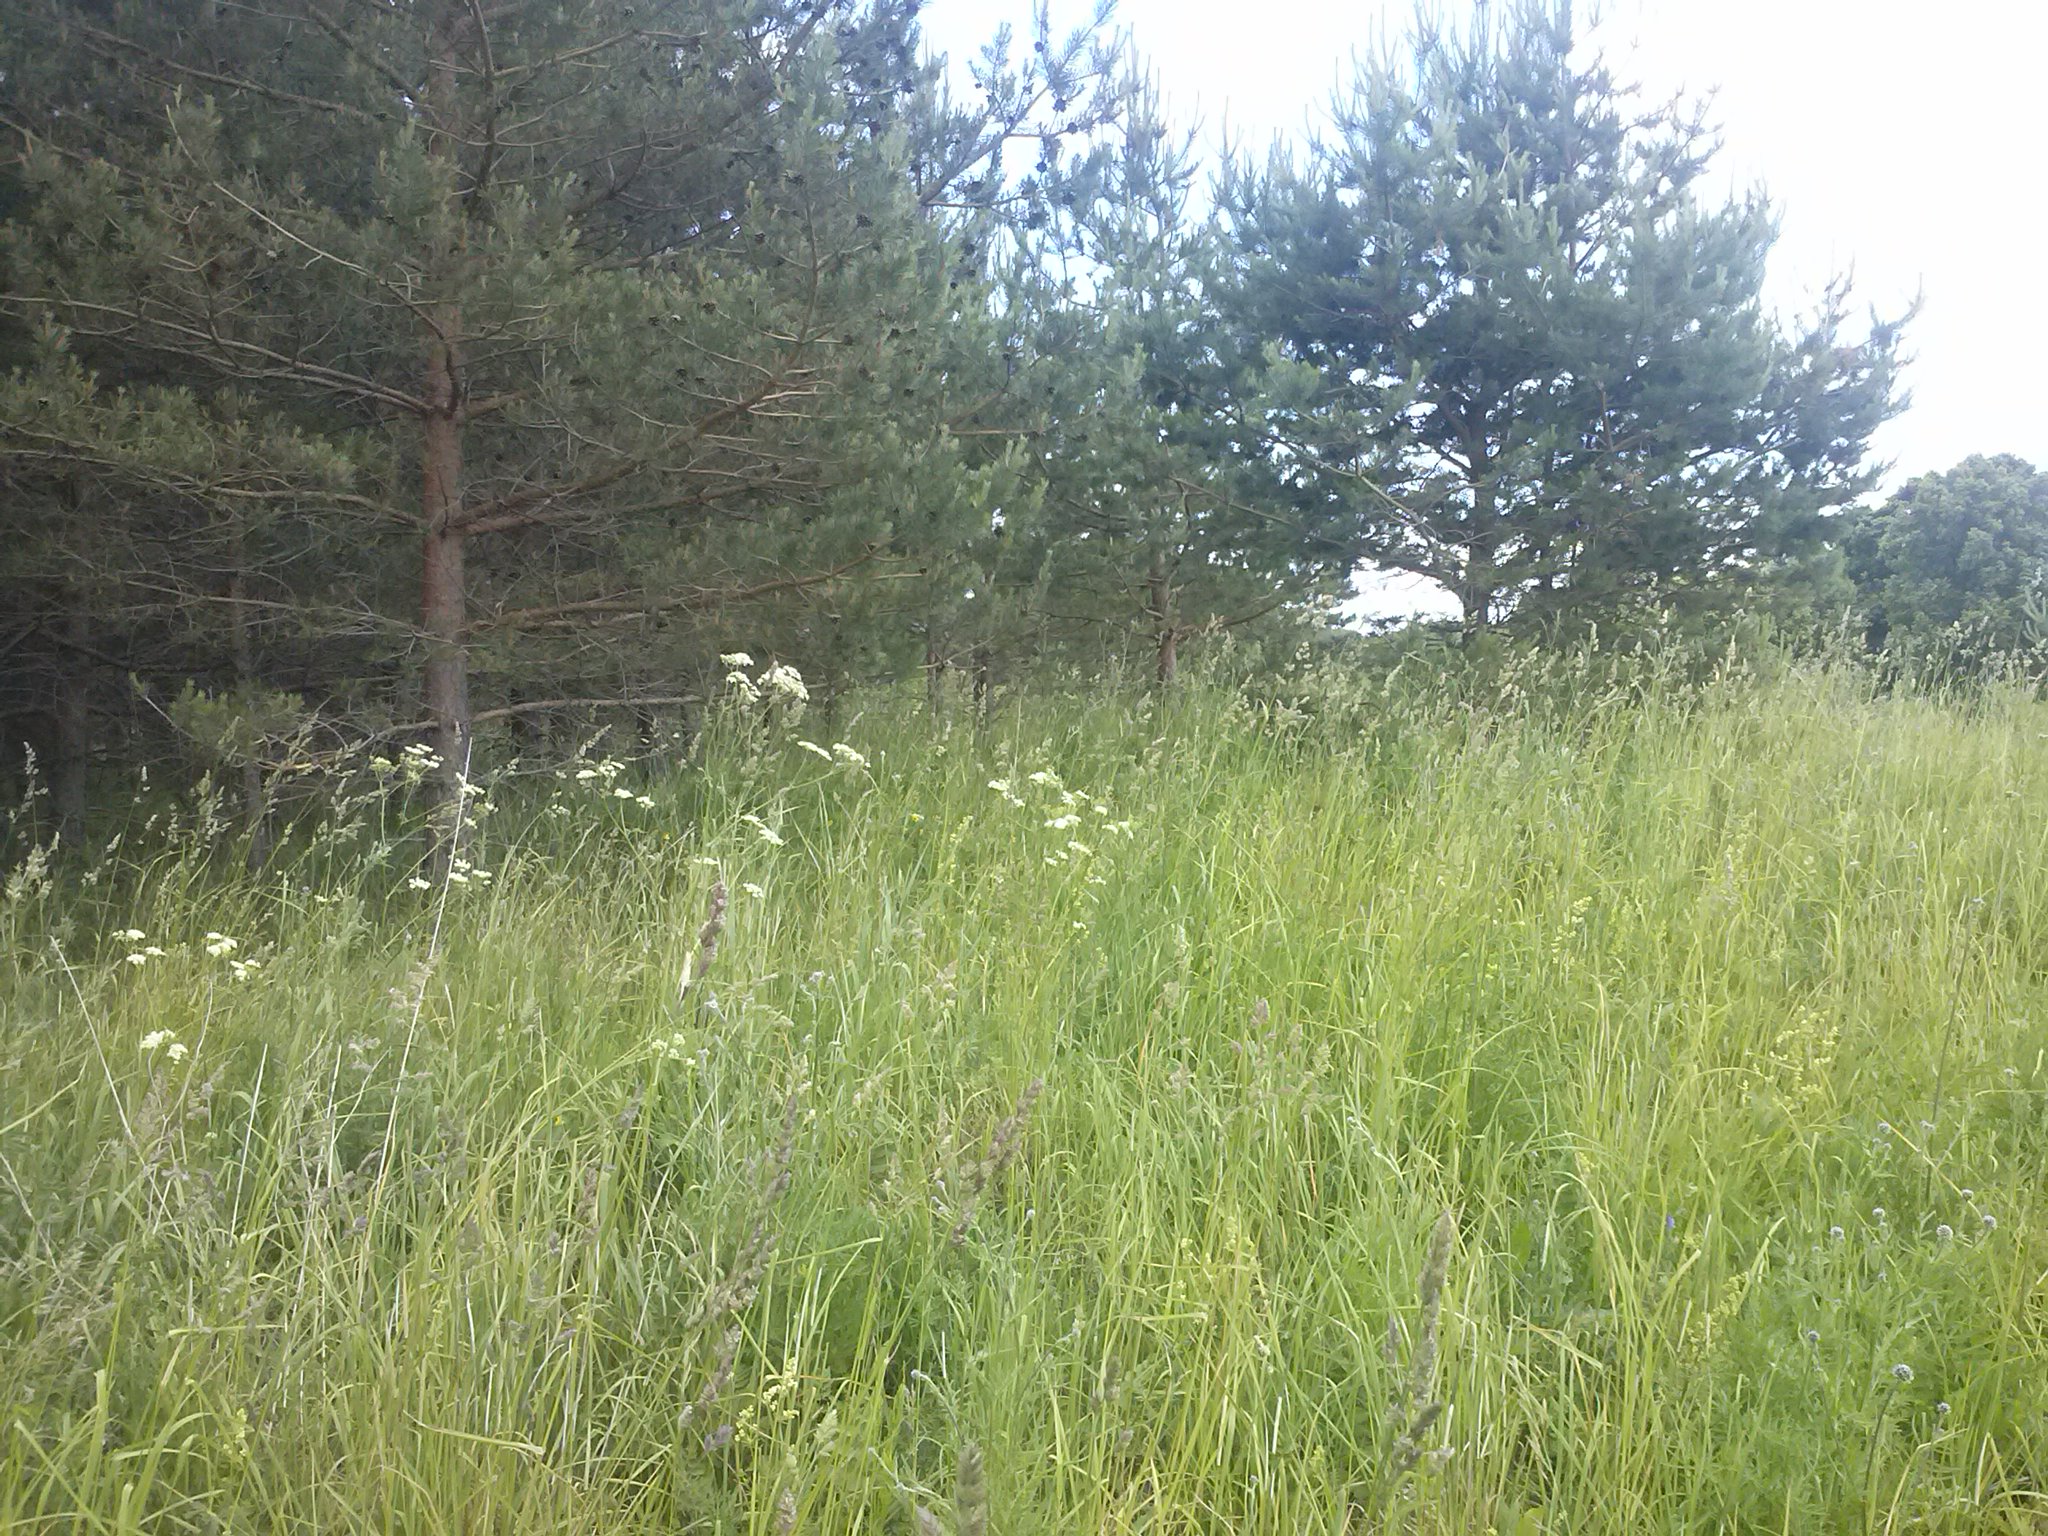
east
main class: Grassland
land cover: Grassland with sparse tree/shrub cover
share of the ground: > 75 %
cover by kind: herbaceous plants 85 %, shrubs 10 %, coniferous forest trees 5 %
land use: Semi-natural and natural areas not in use
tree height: < 5 m
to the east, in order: Grassland with sparse tree/shrub cover; Pine dominated coniferous woodland; Spontaneously vegetated surfaces; Ditches and canals; Spontaneously vegetated surfaces
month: June
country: LV
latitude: 56.4696
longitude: 27.8690
